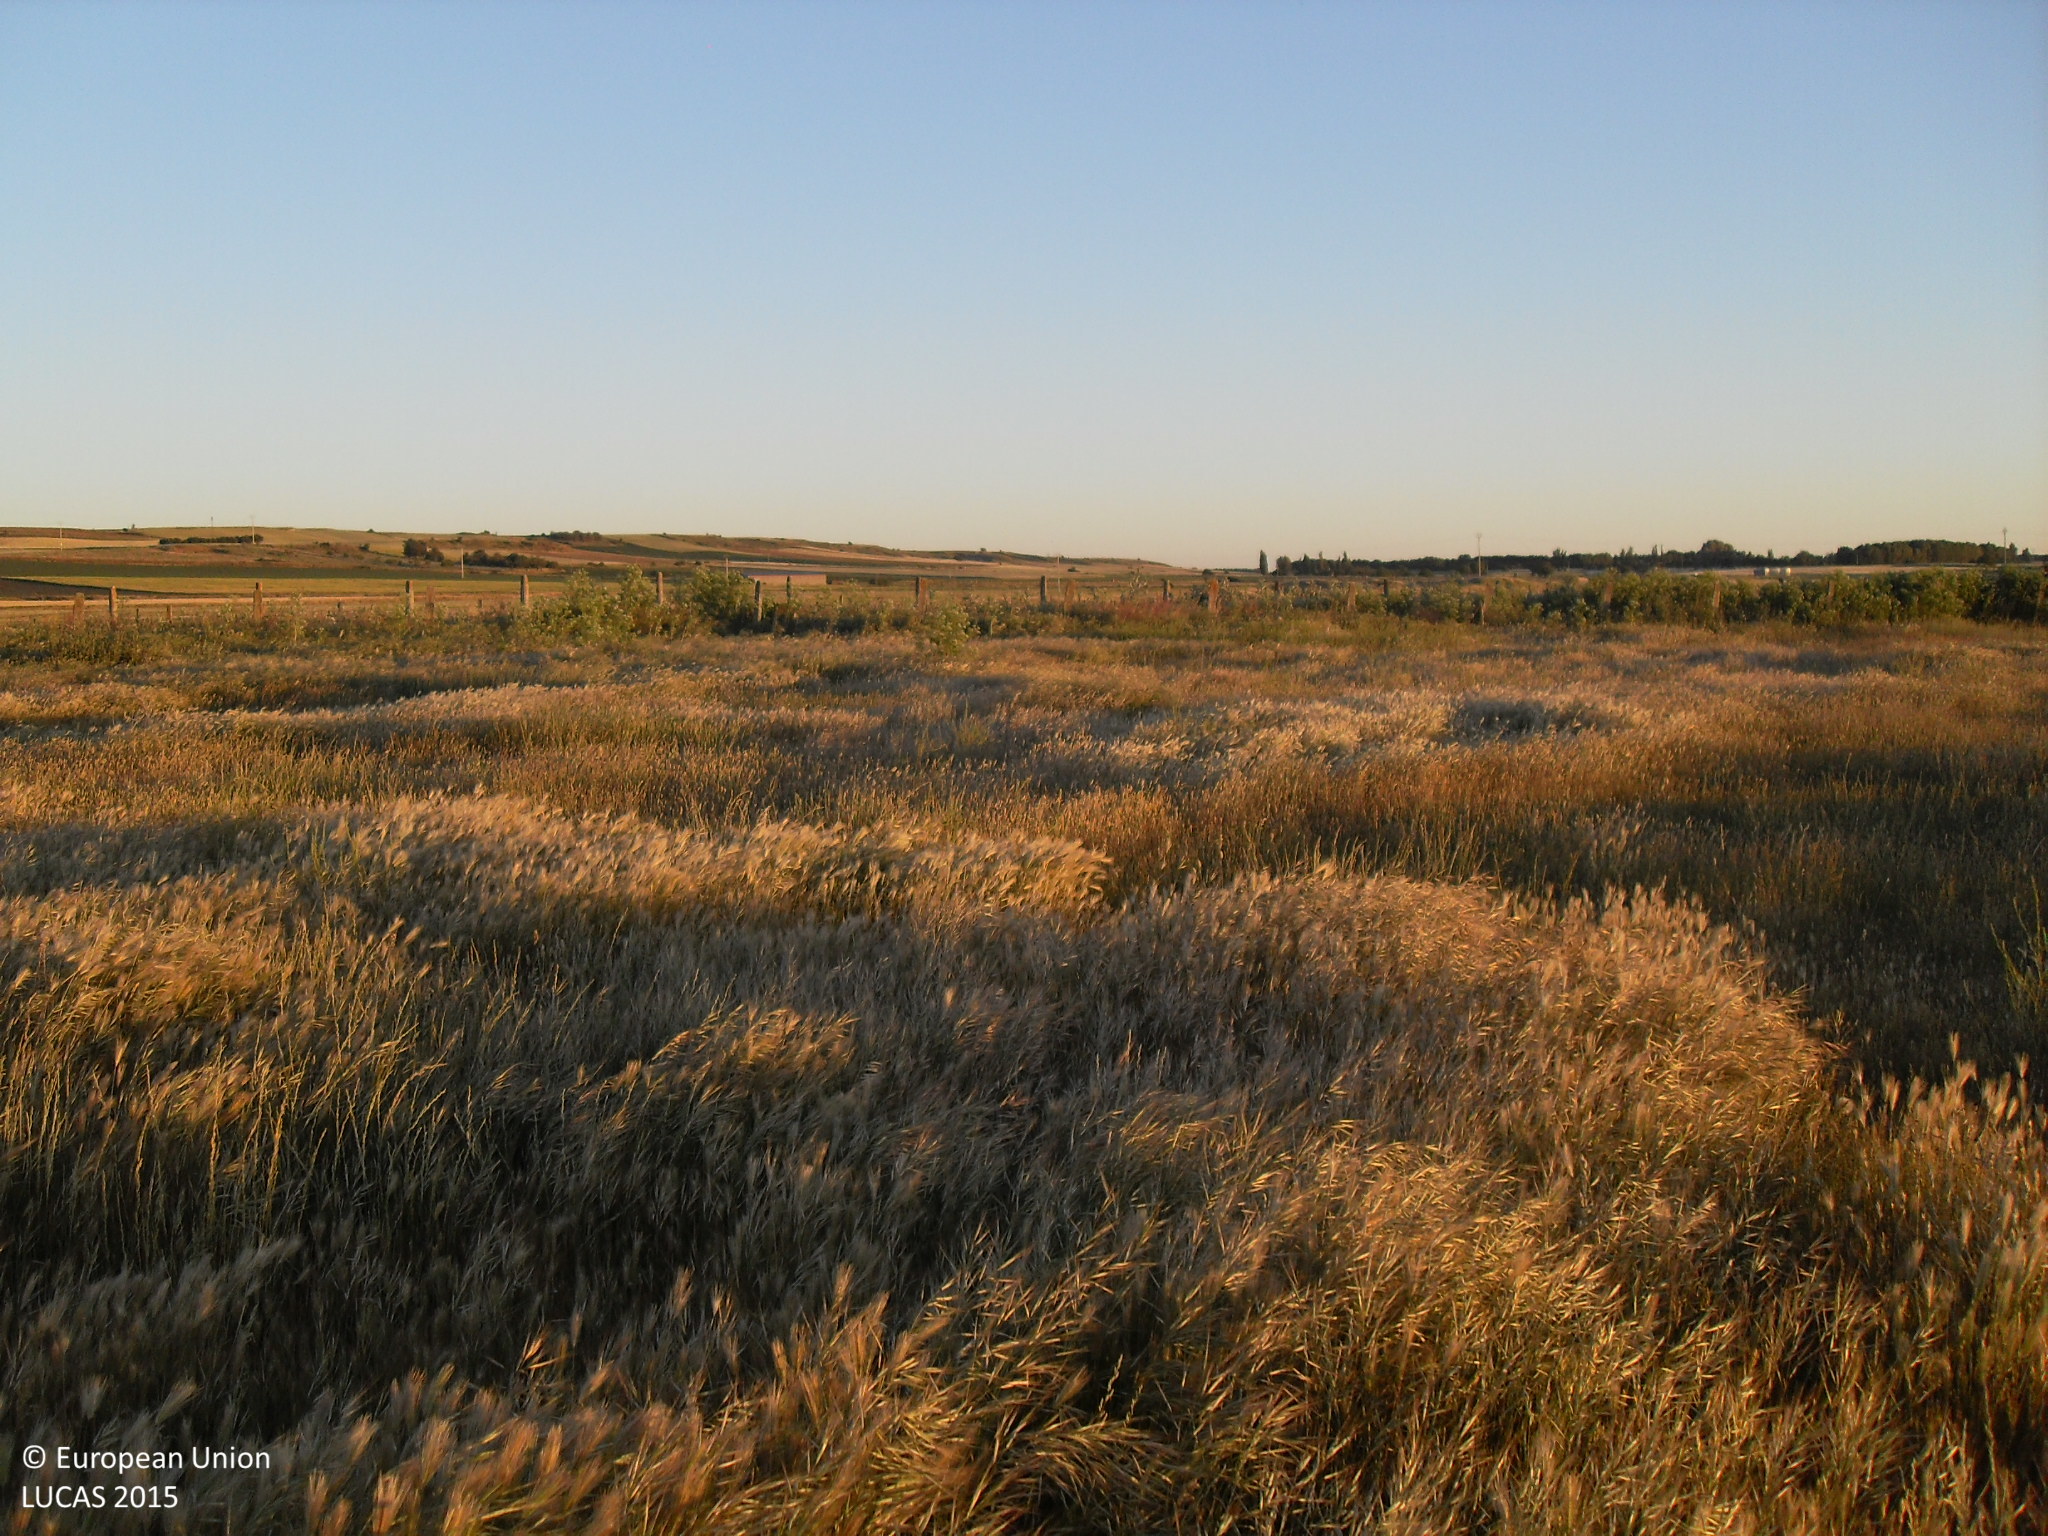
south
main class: Grassland
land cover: Grassland without tree/shrub cover
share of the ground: > 75 %
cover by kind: herbaceous plants 100 %
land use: Agriculture (excluding fallow land and kitchen gardens)
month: May
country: ES
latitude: 41.0592
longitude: -5.3147
